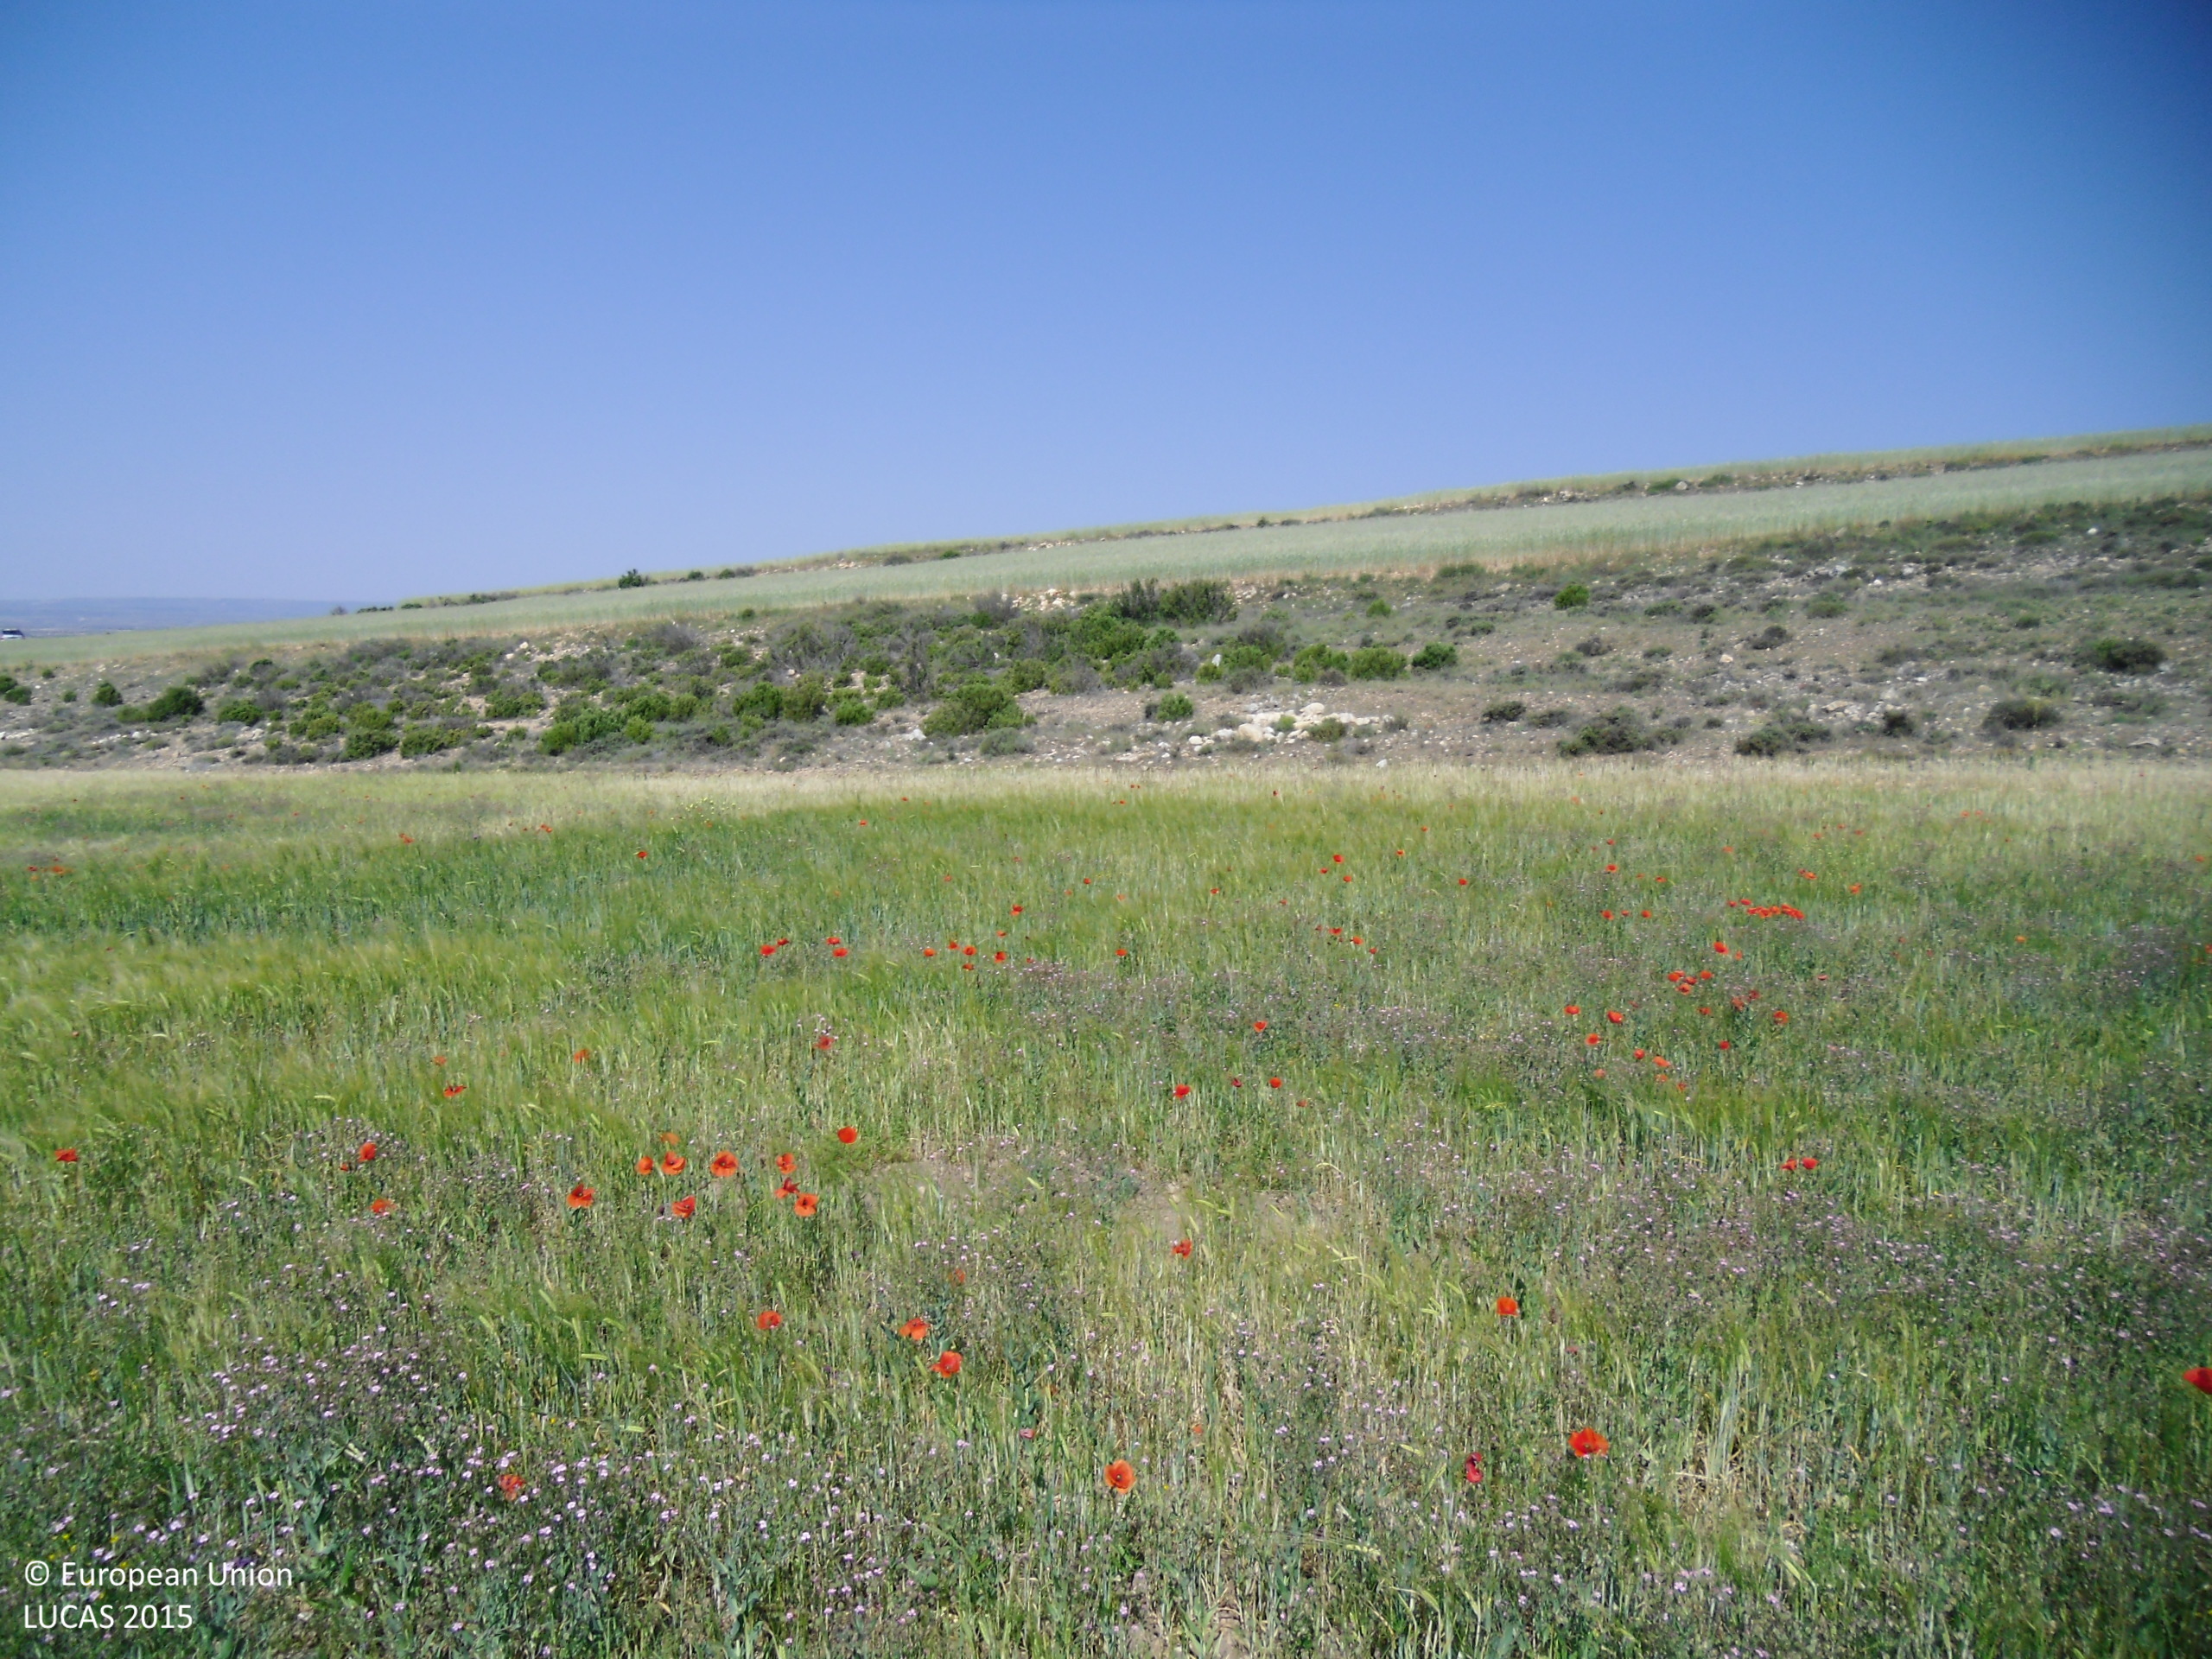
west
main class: Cropland
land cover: Barley
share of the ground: > 75 %
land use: Agriculture (excluding fallow land and kitchen gardens)
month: June
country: ES
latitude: 41.0669
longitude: -0.6897
